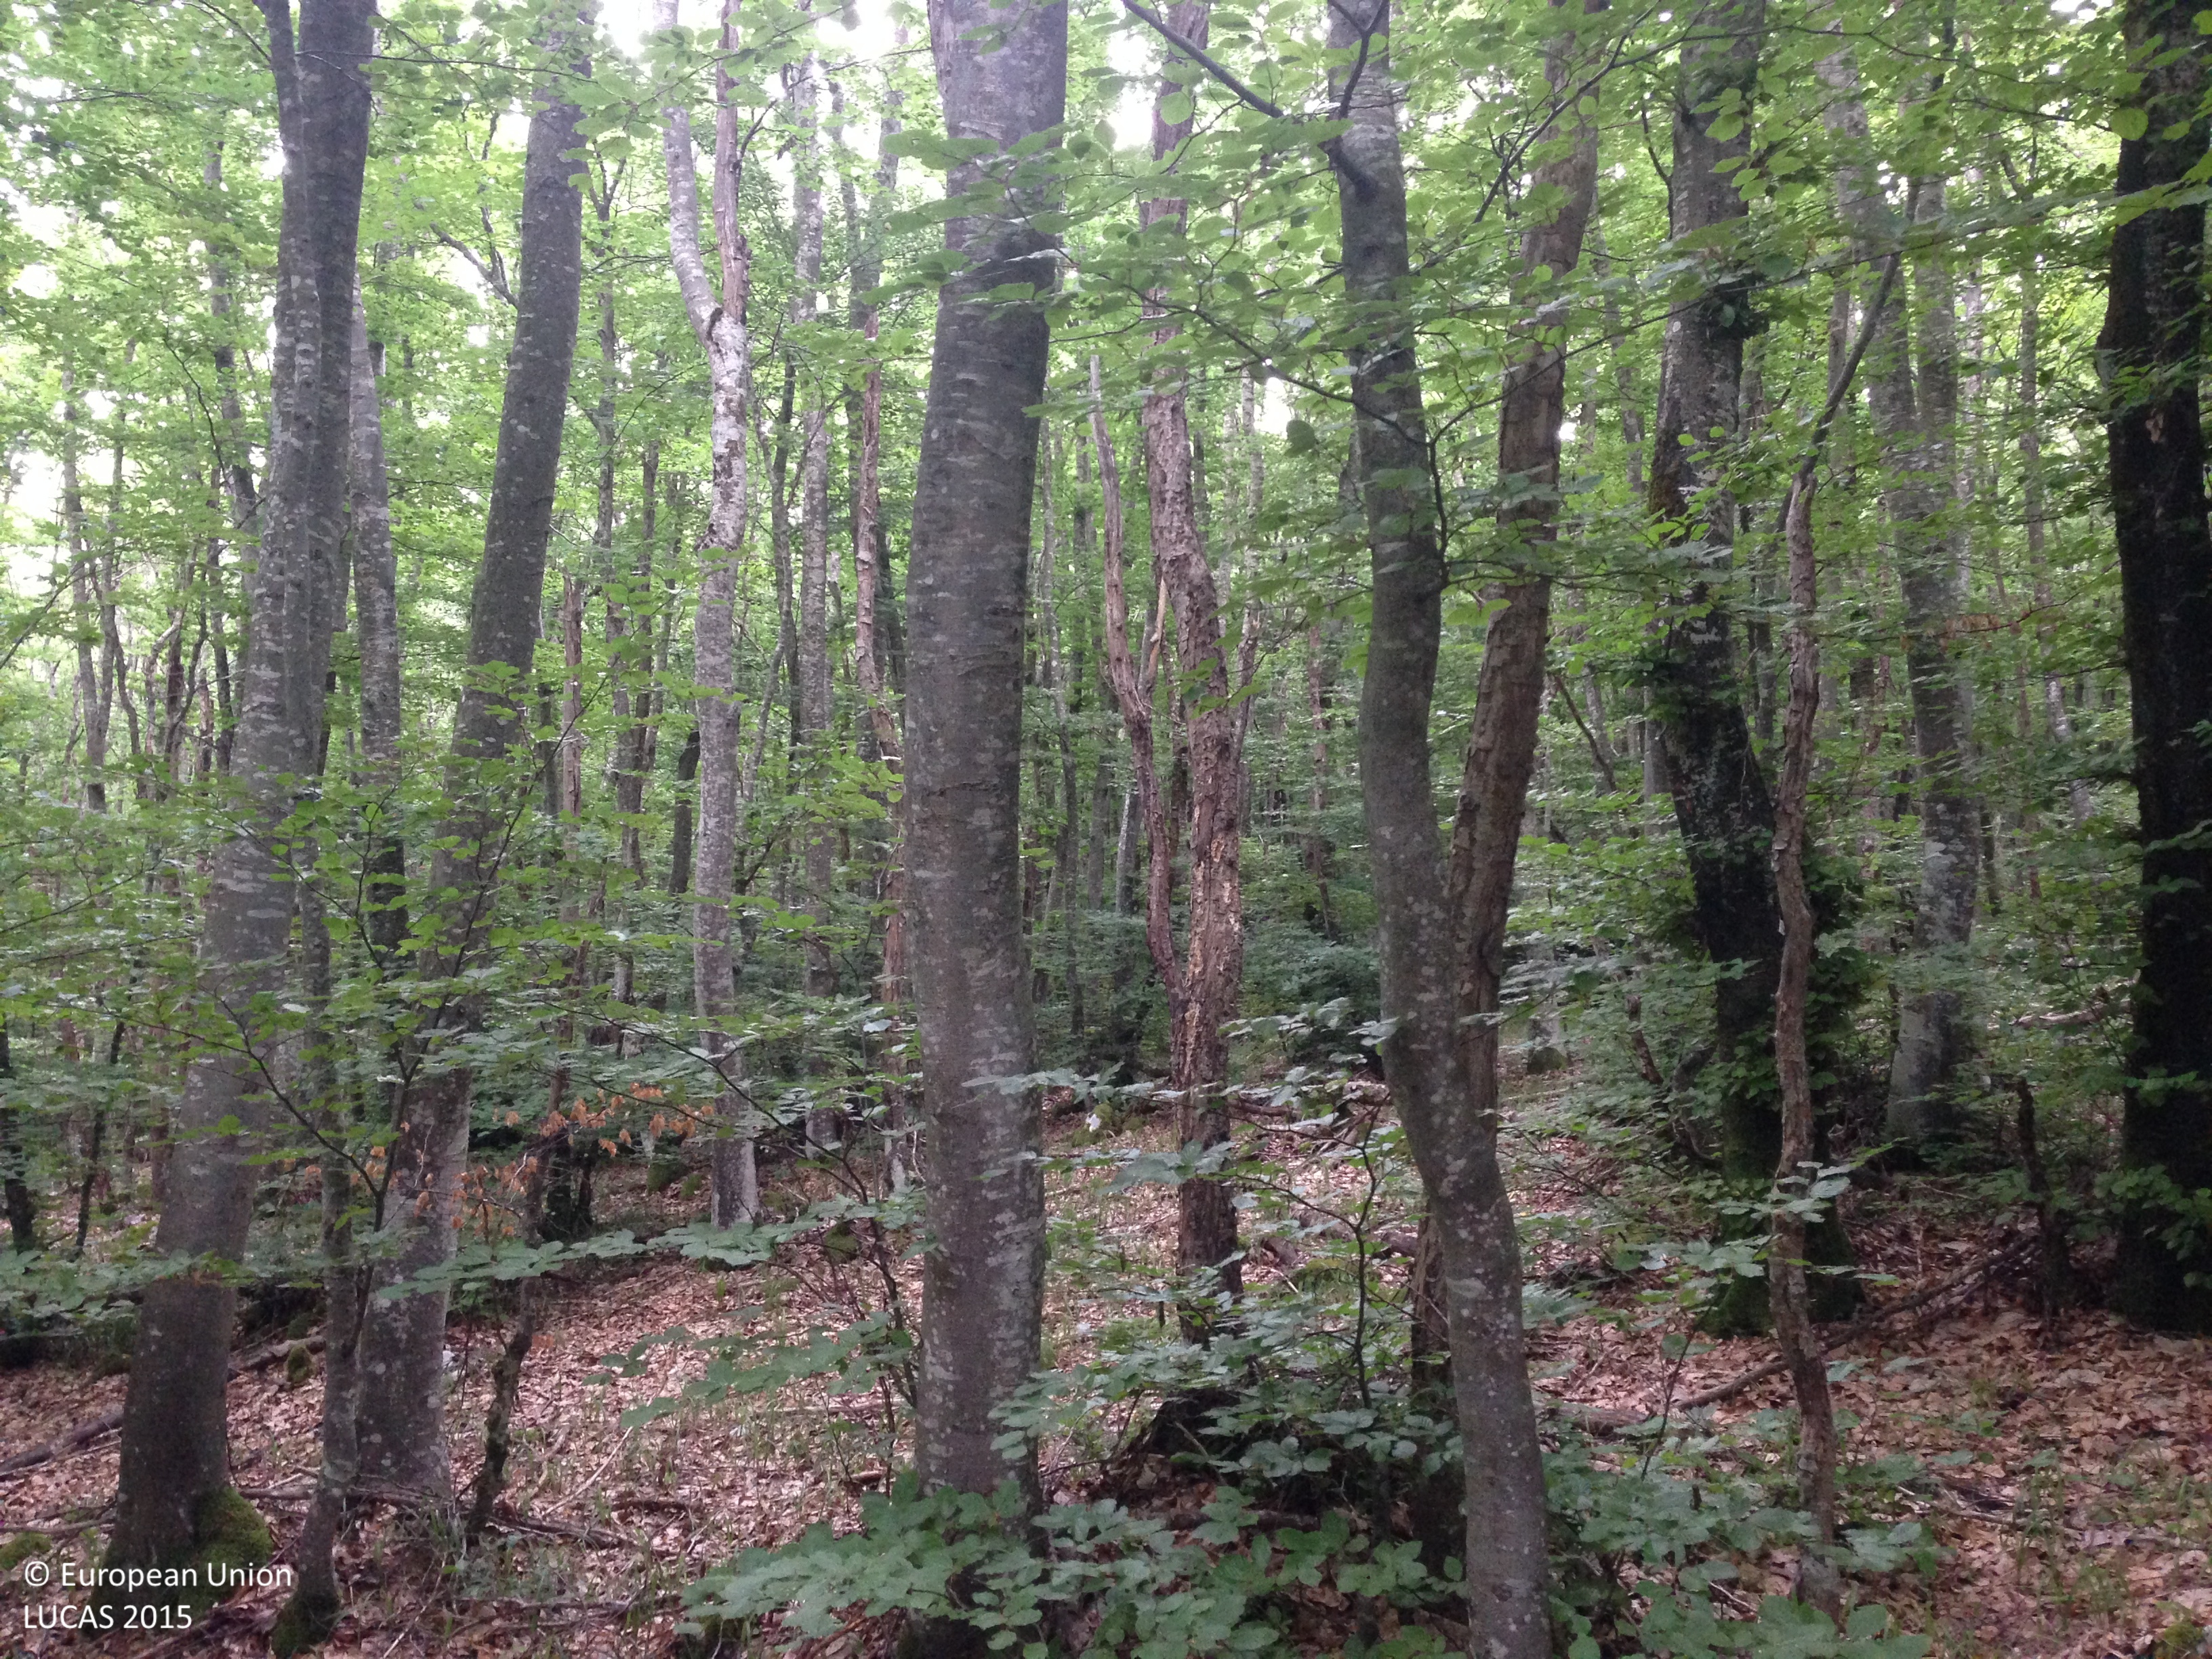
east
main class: Woodland
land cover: Broadleaved woodland
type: mountainous beech forest
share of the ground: > 75 %
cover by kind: broadleaved forest trees 80 %, shrubs 10 %, herbaceous plants 5 %, consolidated bare surface 5 %
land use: Forestry
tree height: > 5 m
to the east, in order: Broadleaved woodland
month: June
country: HR
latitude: 44.6994
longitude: 15.7110
